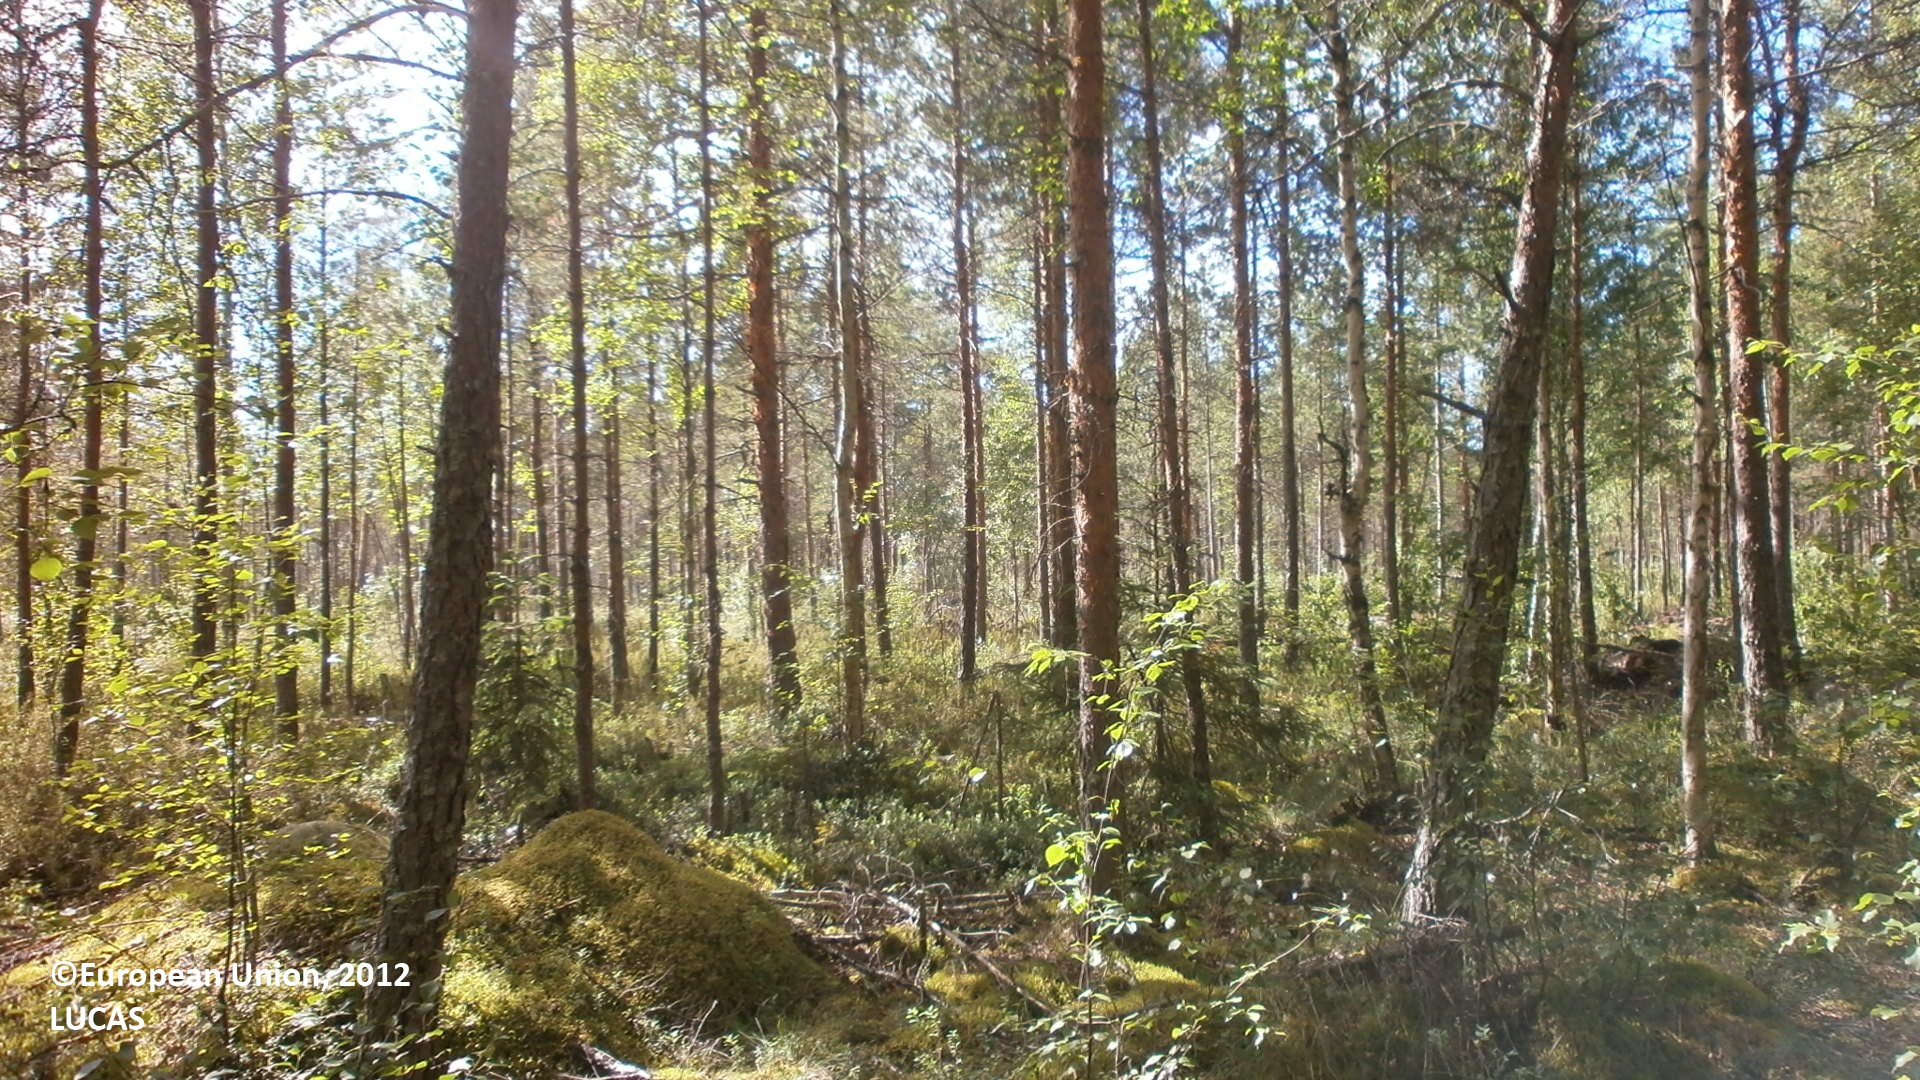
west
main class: Woodland
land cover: Pine dominated mixed woodland
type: boreal forest
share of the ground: 50 - 75 %
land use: Forestry
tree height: > 5 m
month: July
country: FI
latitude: 64.0063
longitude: 23.8671
